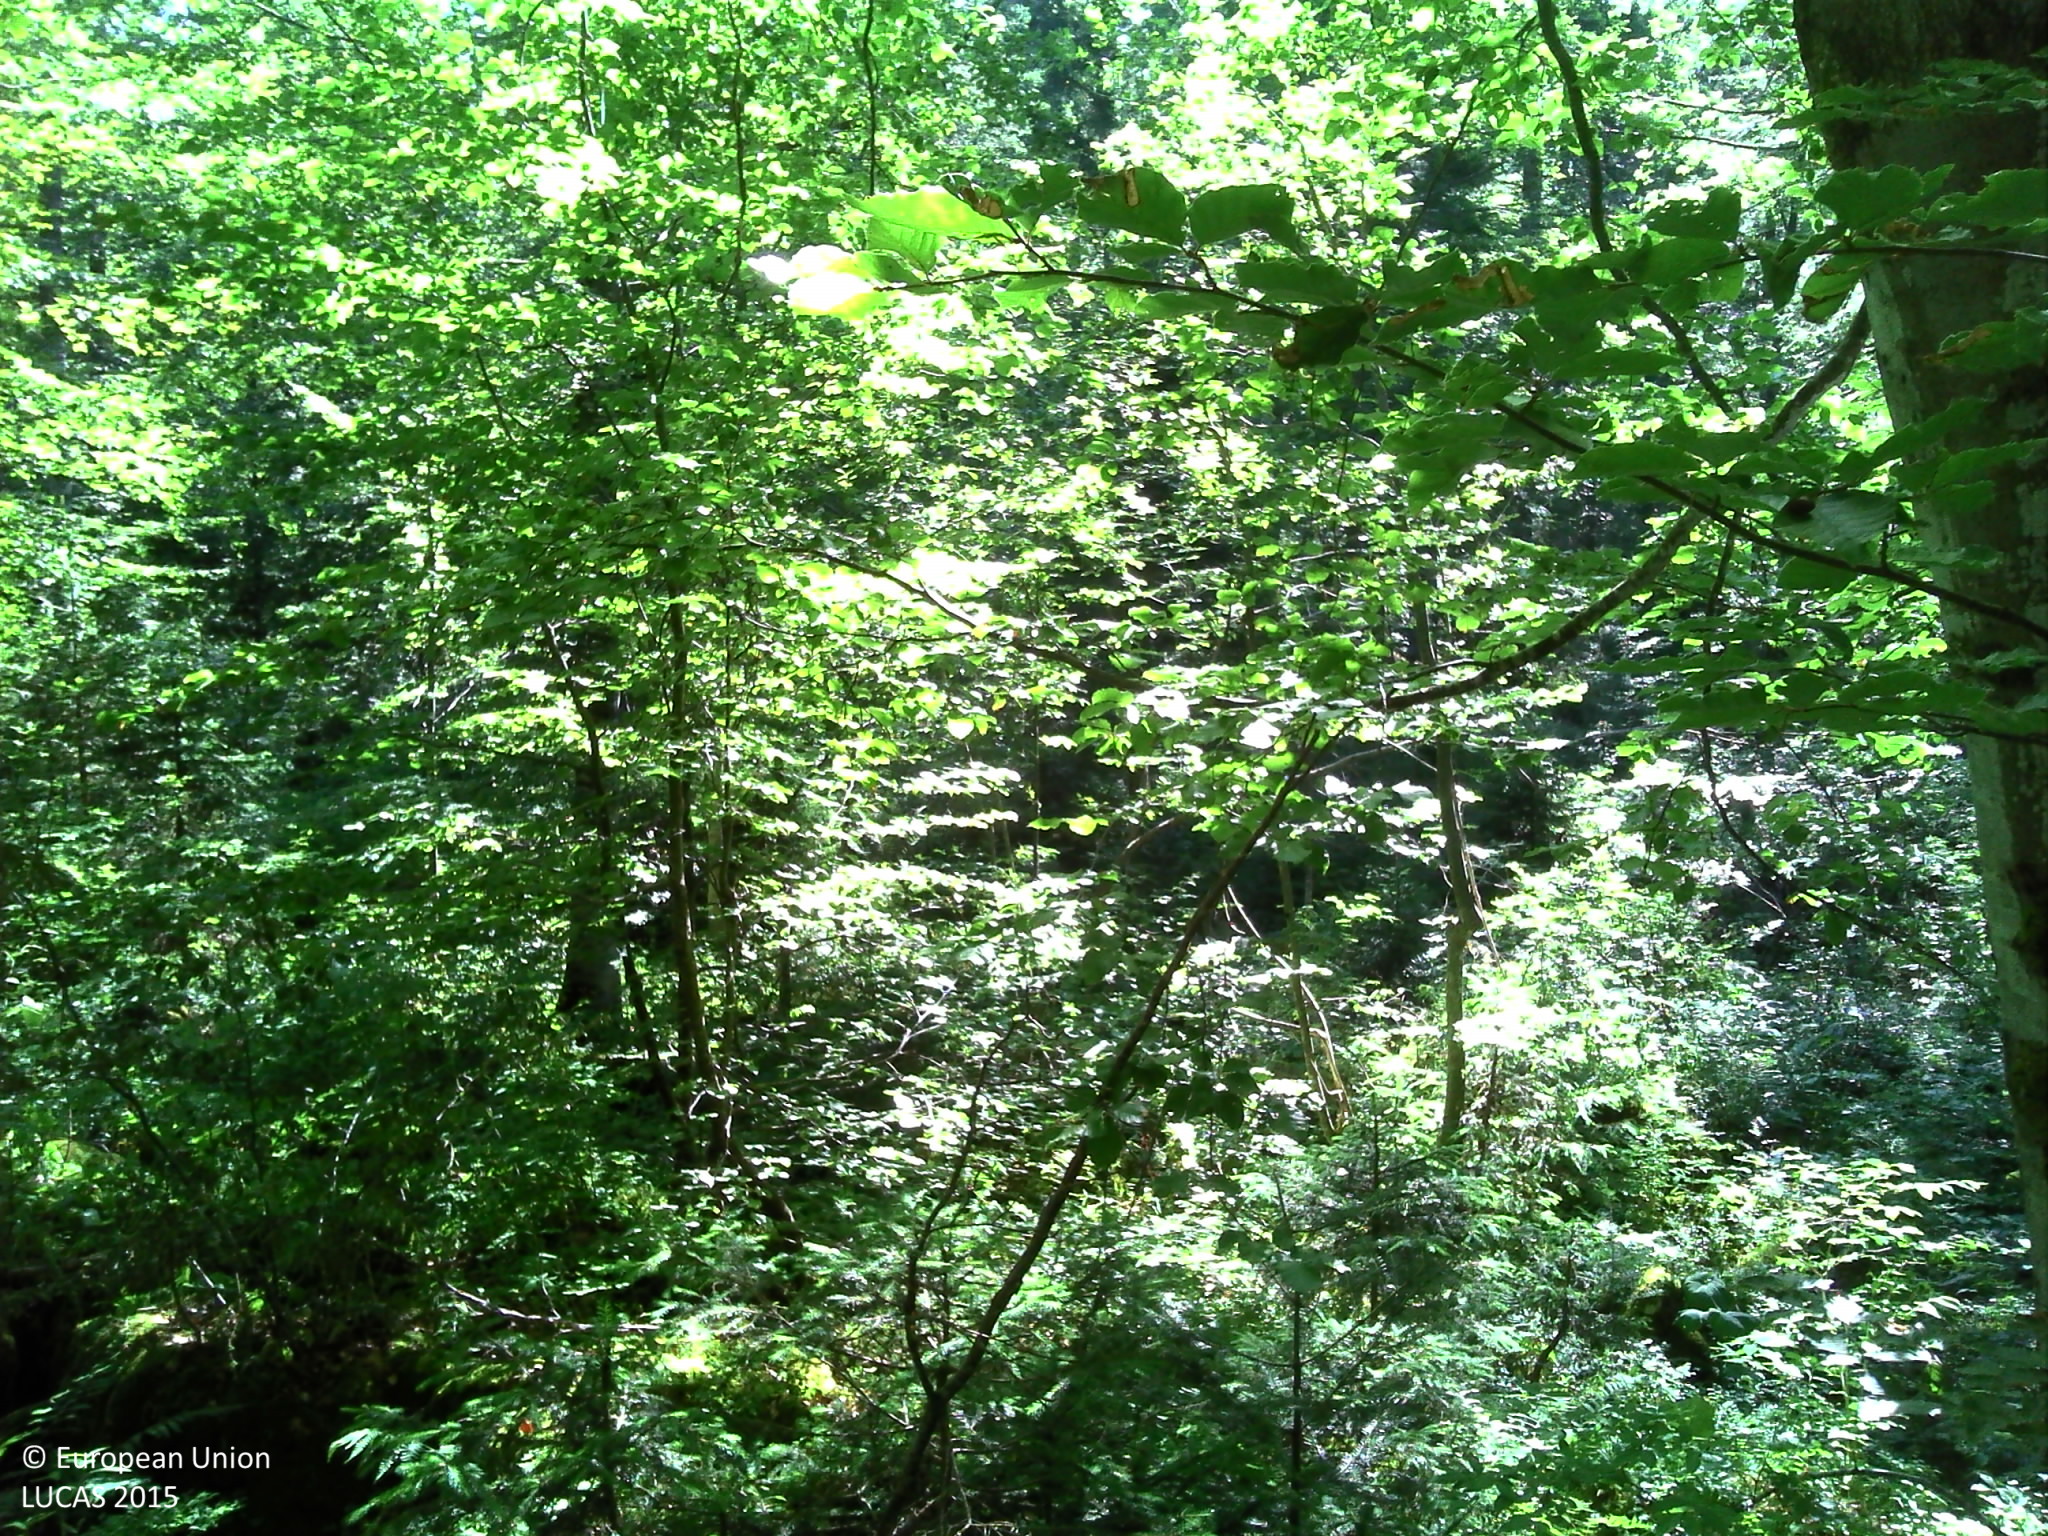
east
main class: Woodland
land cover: Spruce dominated mixed woodland
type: mountainous beech forest
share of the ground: > 75 %
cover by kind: broadleaved forest trees 35 %, coniferous forest trees 30 %, consolidated bare surface 20 %, lichens and mosses 10 %, herbaceous plants 5 %
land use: Forestry
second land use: Sport
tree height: > 5 m
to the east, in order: Spruce dominated mixed woodland; Tracks; Spruce dominated mixed woodland
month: July
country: FR
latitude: 46.5687
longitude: 6.1019
